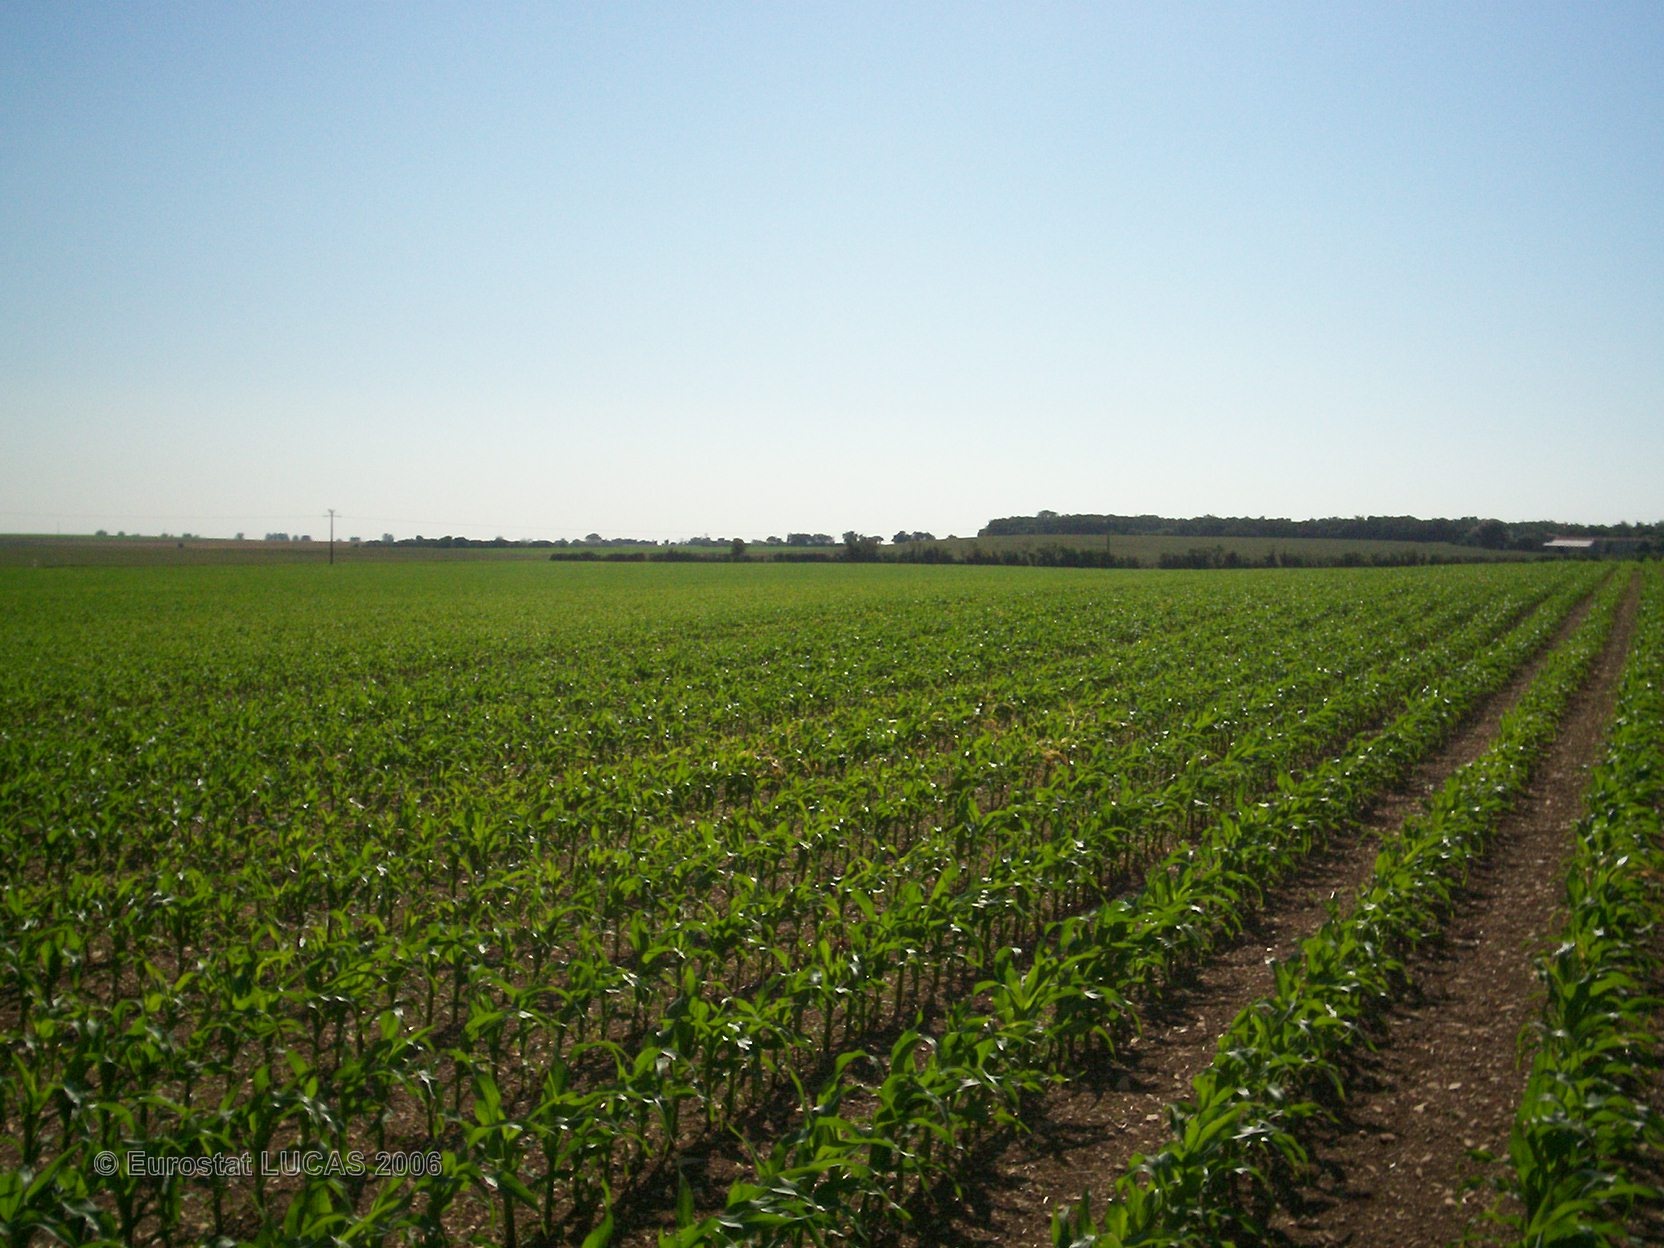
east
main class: Cropland
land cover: Maize
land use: Agriculture (excluding fallow land and kitchen gardens)
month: June
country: FR
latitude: 46.1926
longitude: -0.7172
